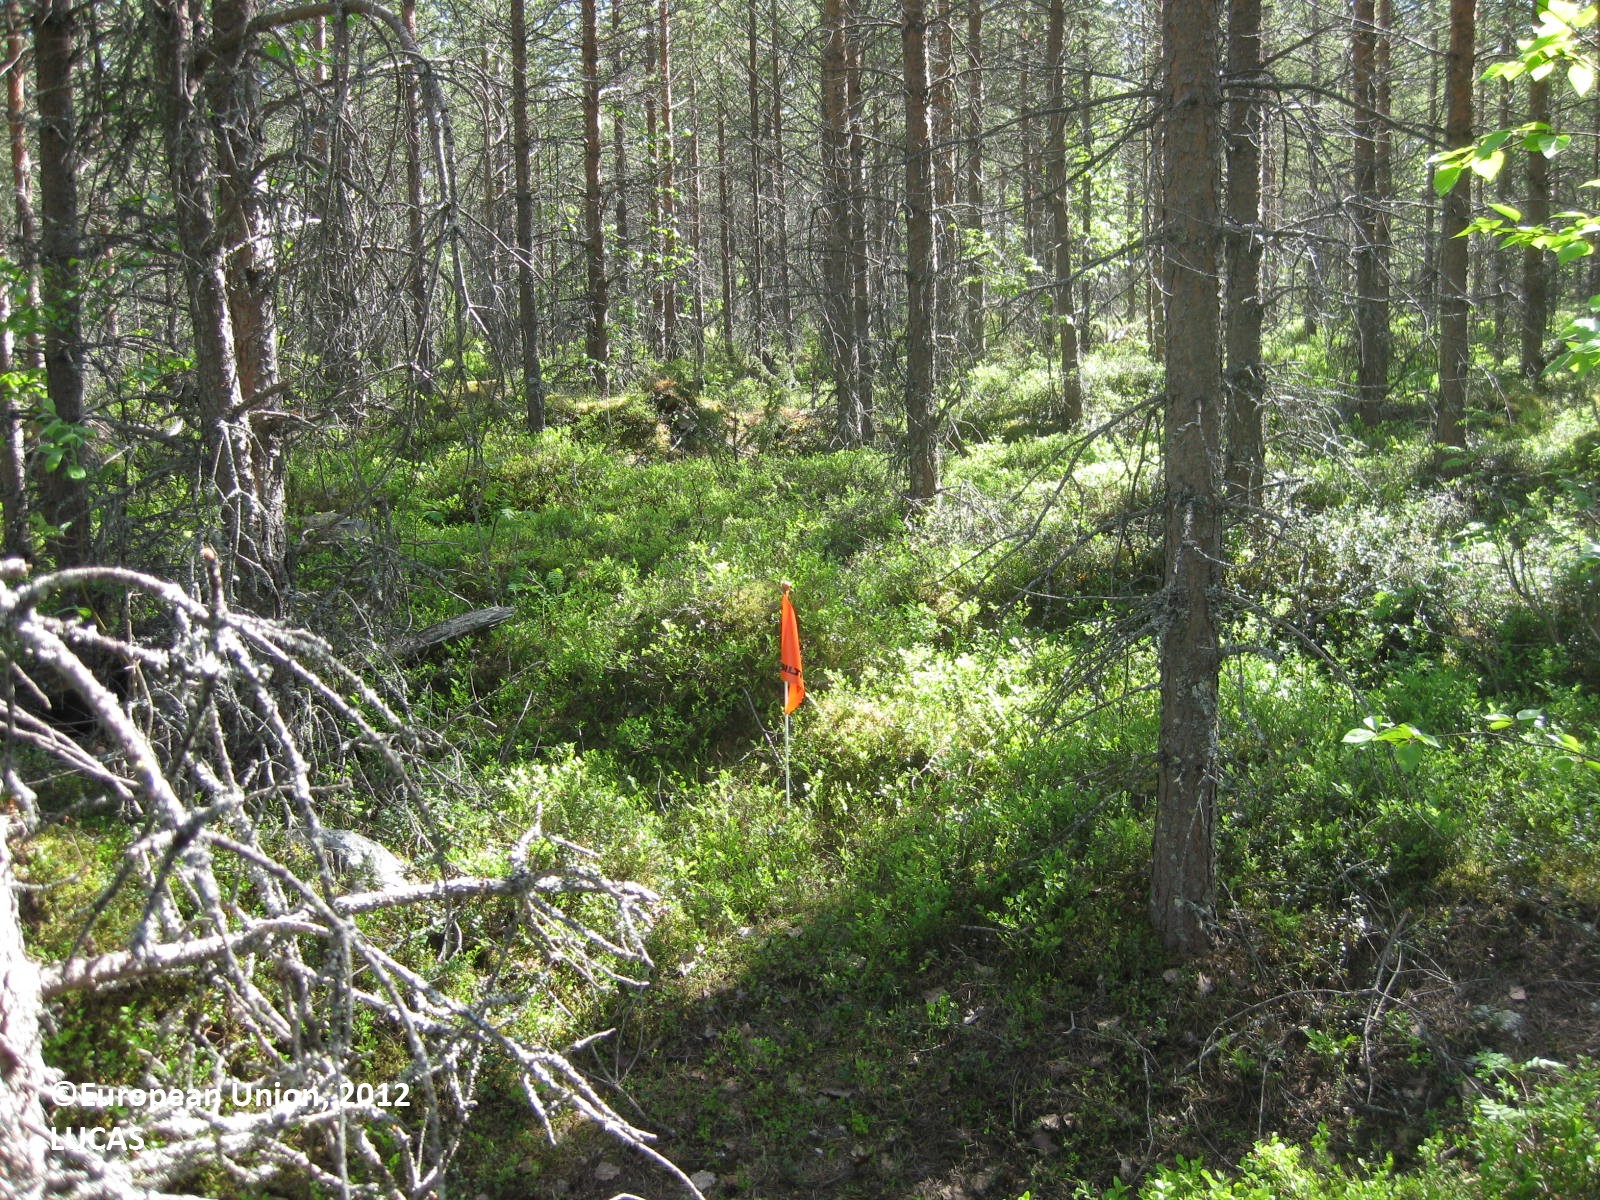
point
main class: Woodland
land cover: Pine dominated coniferous woodland
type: boreal forest
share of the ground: > 75 %
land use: Forestry
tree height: > 5 m
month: June
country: FI
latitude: 65.0340
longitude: 28.8010
